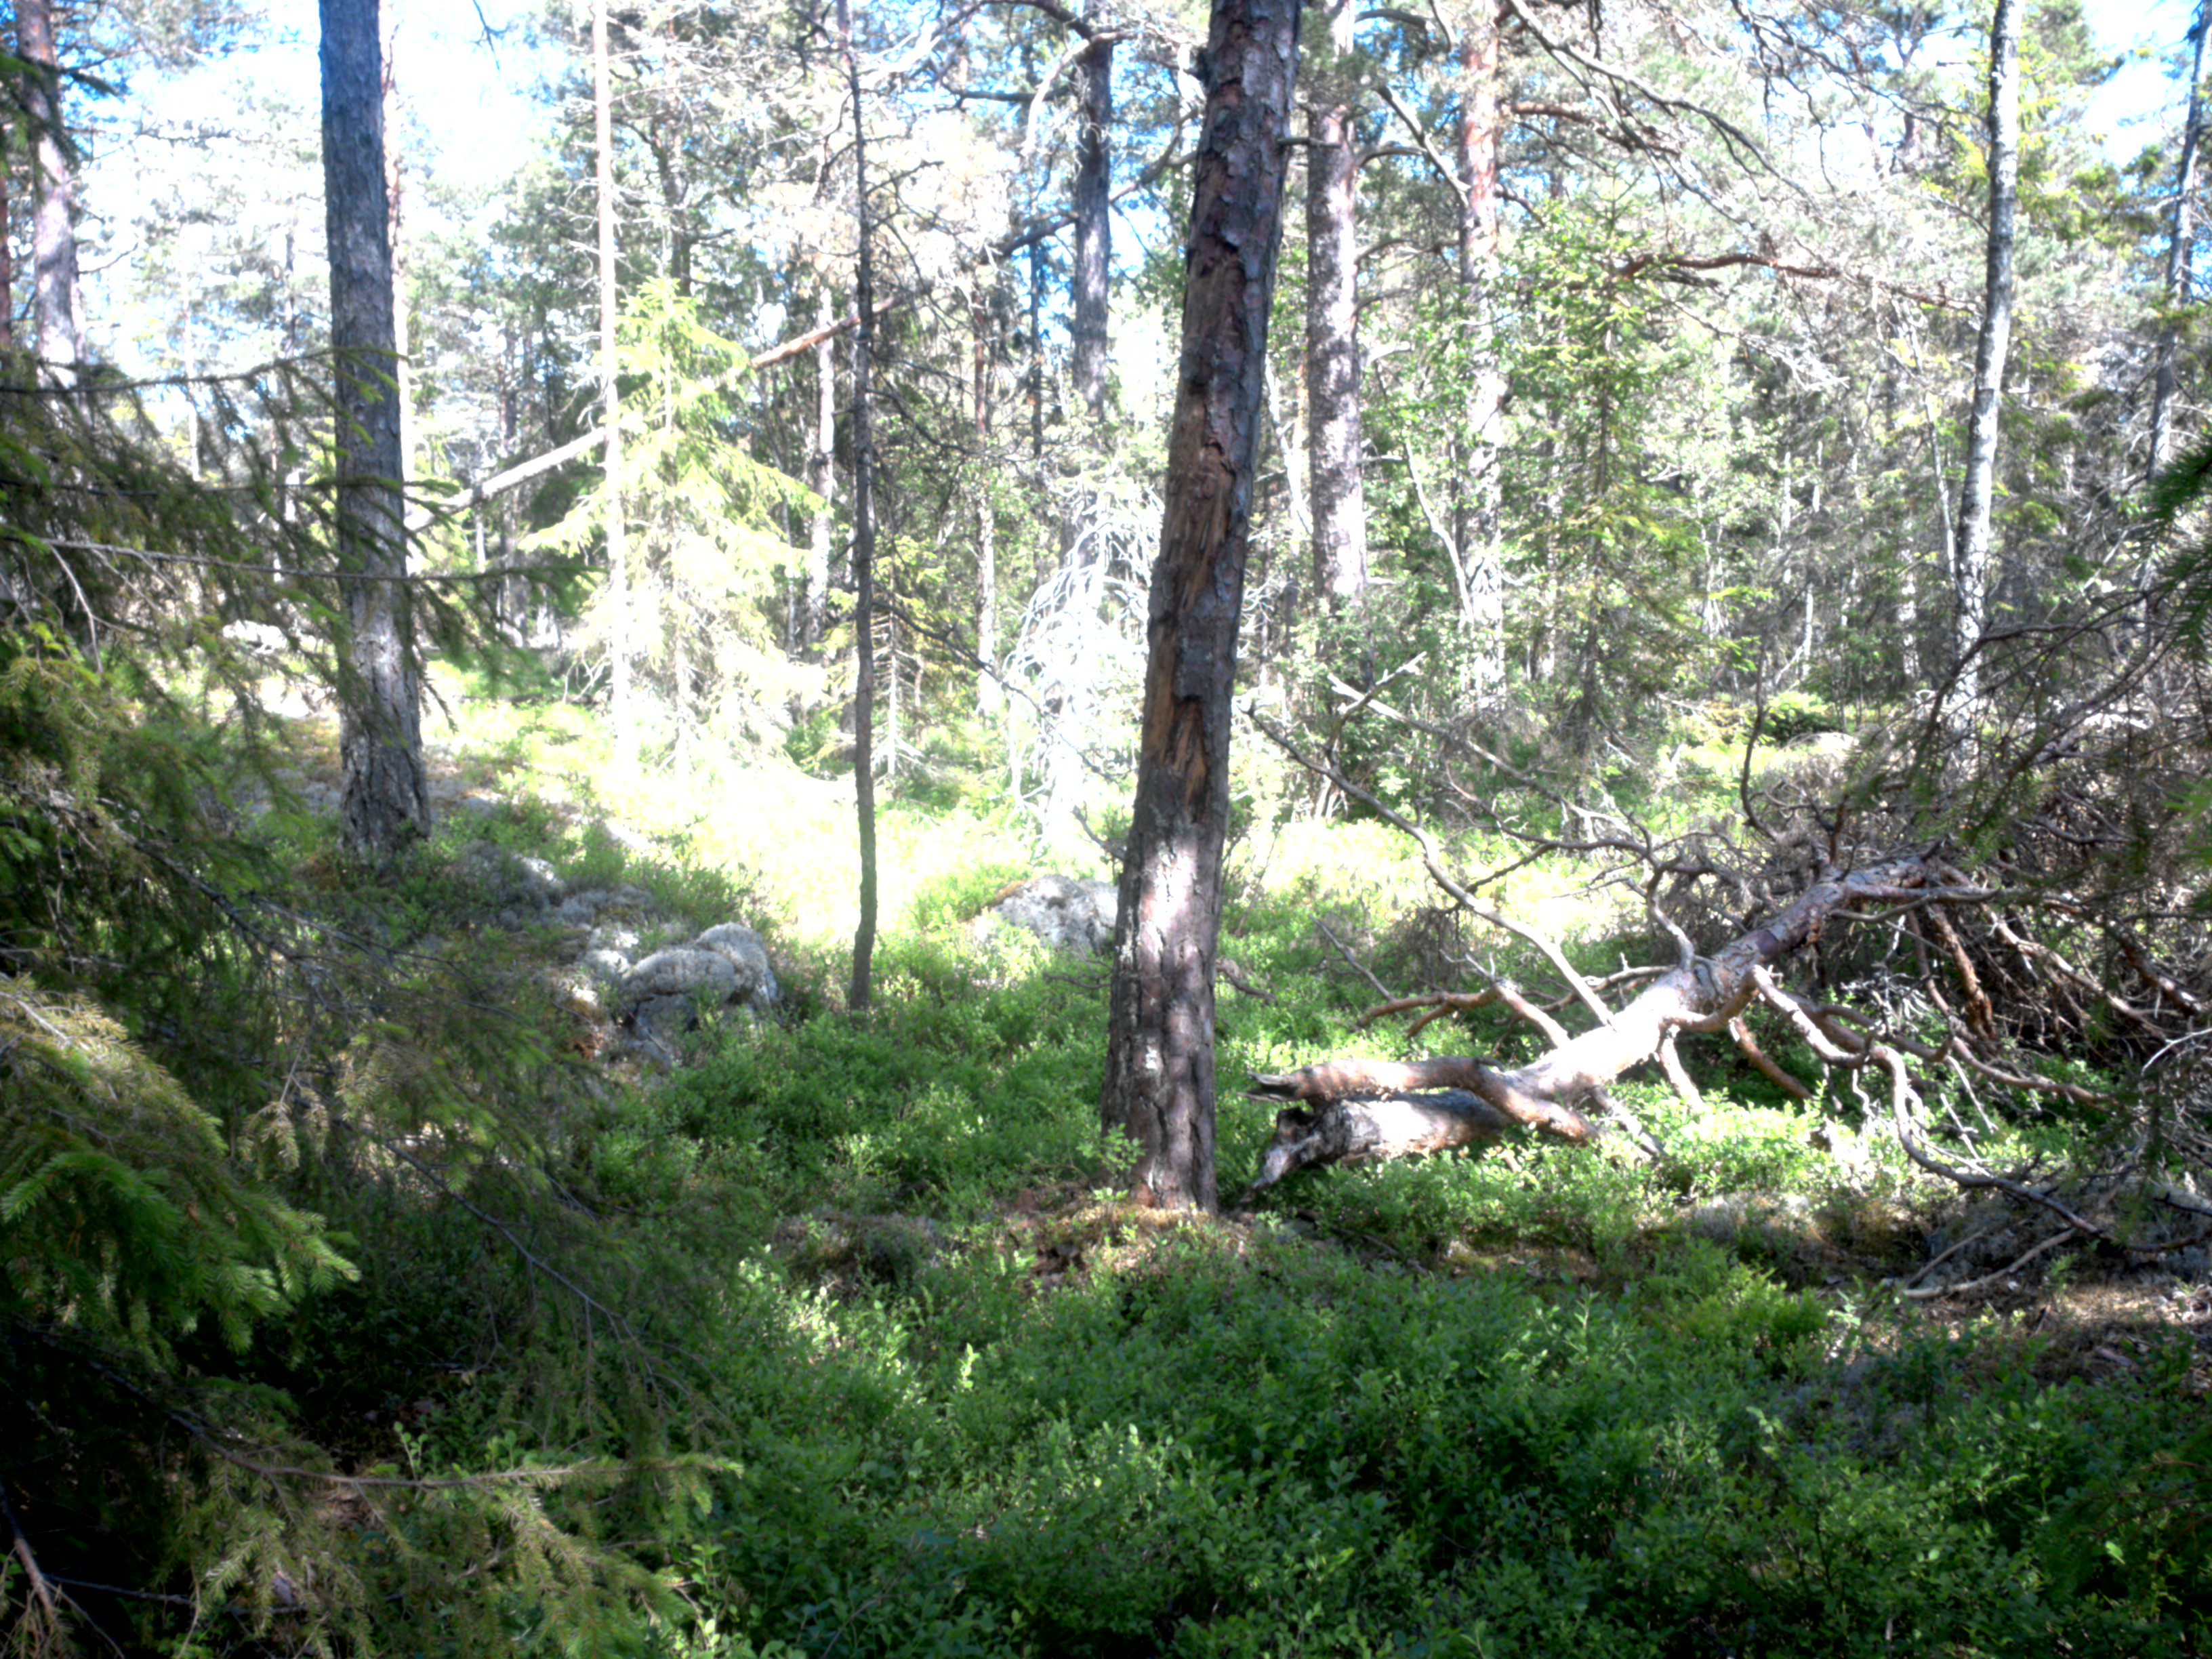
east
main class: Woodland
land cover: Pine dominated coniferous woodland
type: boreal forest
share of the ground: 25 - 50 %
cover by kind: coniferous forest trees 50 %, shrubs 45 %, lichens and mosses 5 %
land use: Amenities, museums, leisure
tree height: > 5 m
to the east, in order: Pine dominated coniferous woodland; Tracks; Pine dominated coniferous woodland
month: June
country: SE
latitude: 59.1788
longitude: 18.2419
